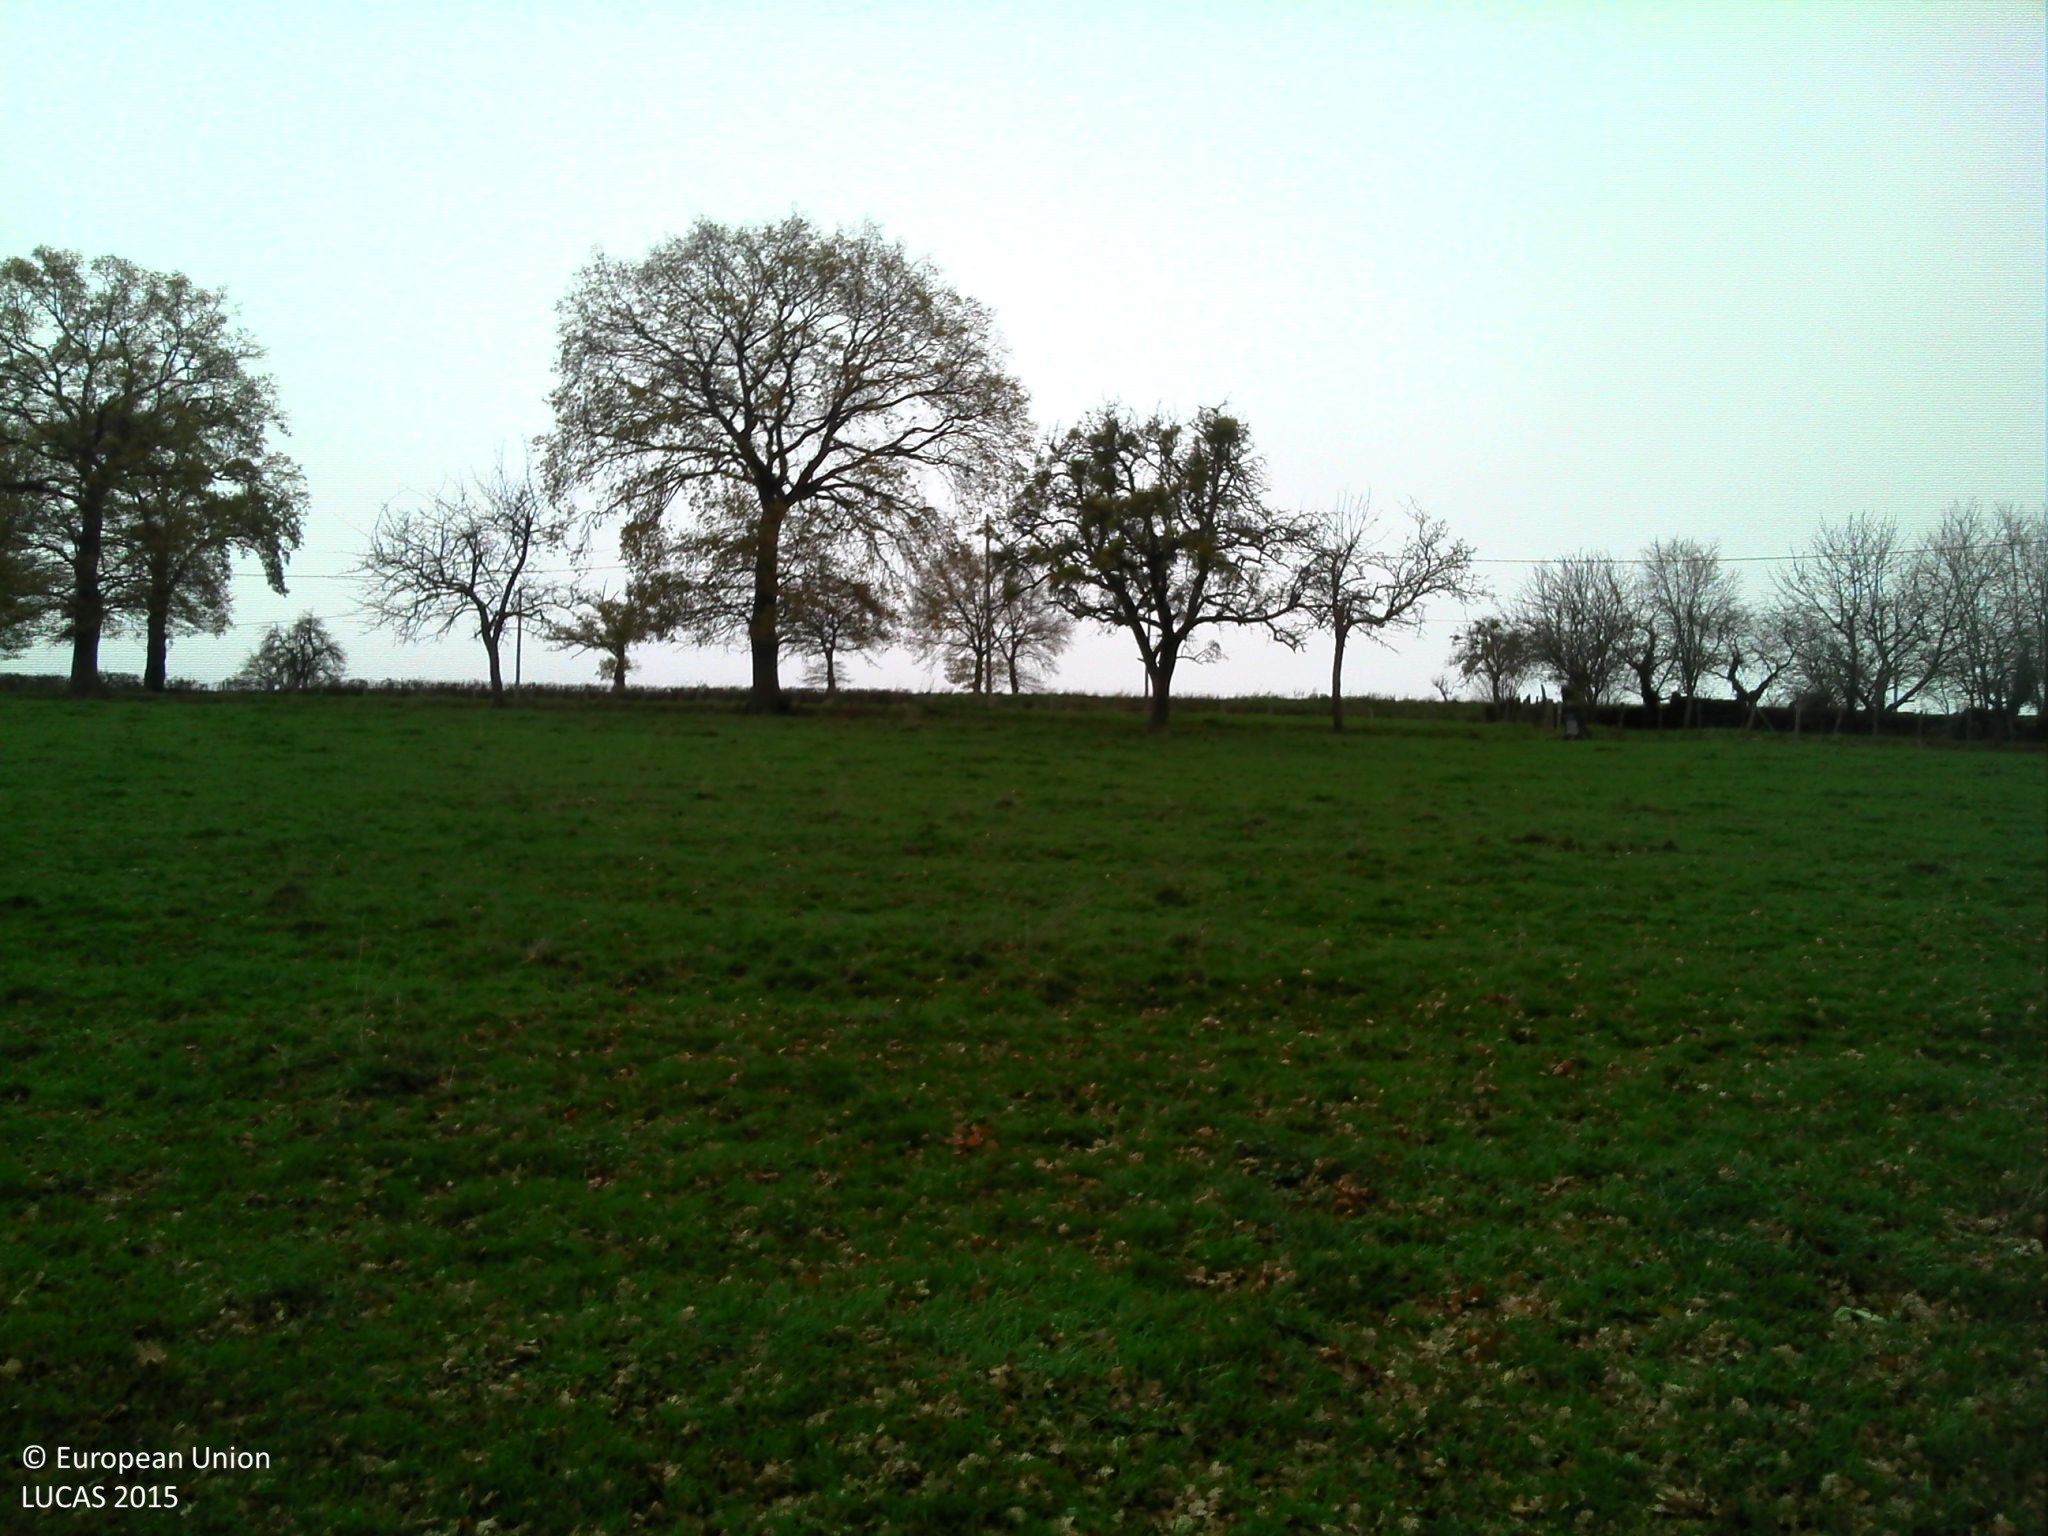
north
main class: Grassland
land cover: Grassland without tree/shrub cover
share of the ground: > 75 %
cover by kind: herbaceous plants 100 %
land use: Agriculture (excluding fallow land and kitchen gardens)
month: November
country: FR
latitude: 46.3280
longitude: 3.7001
